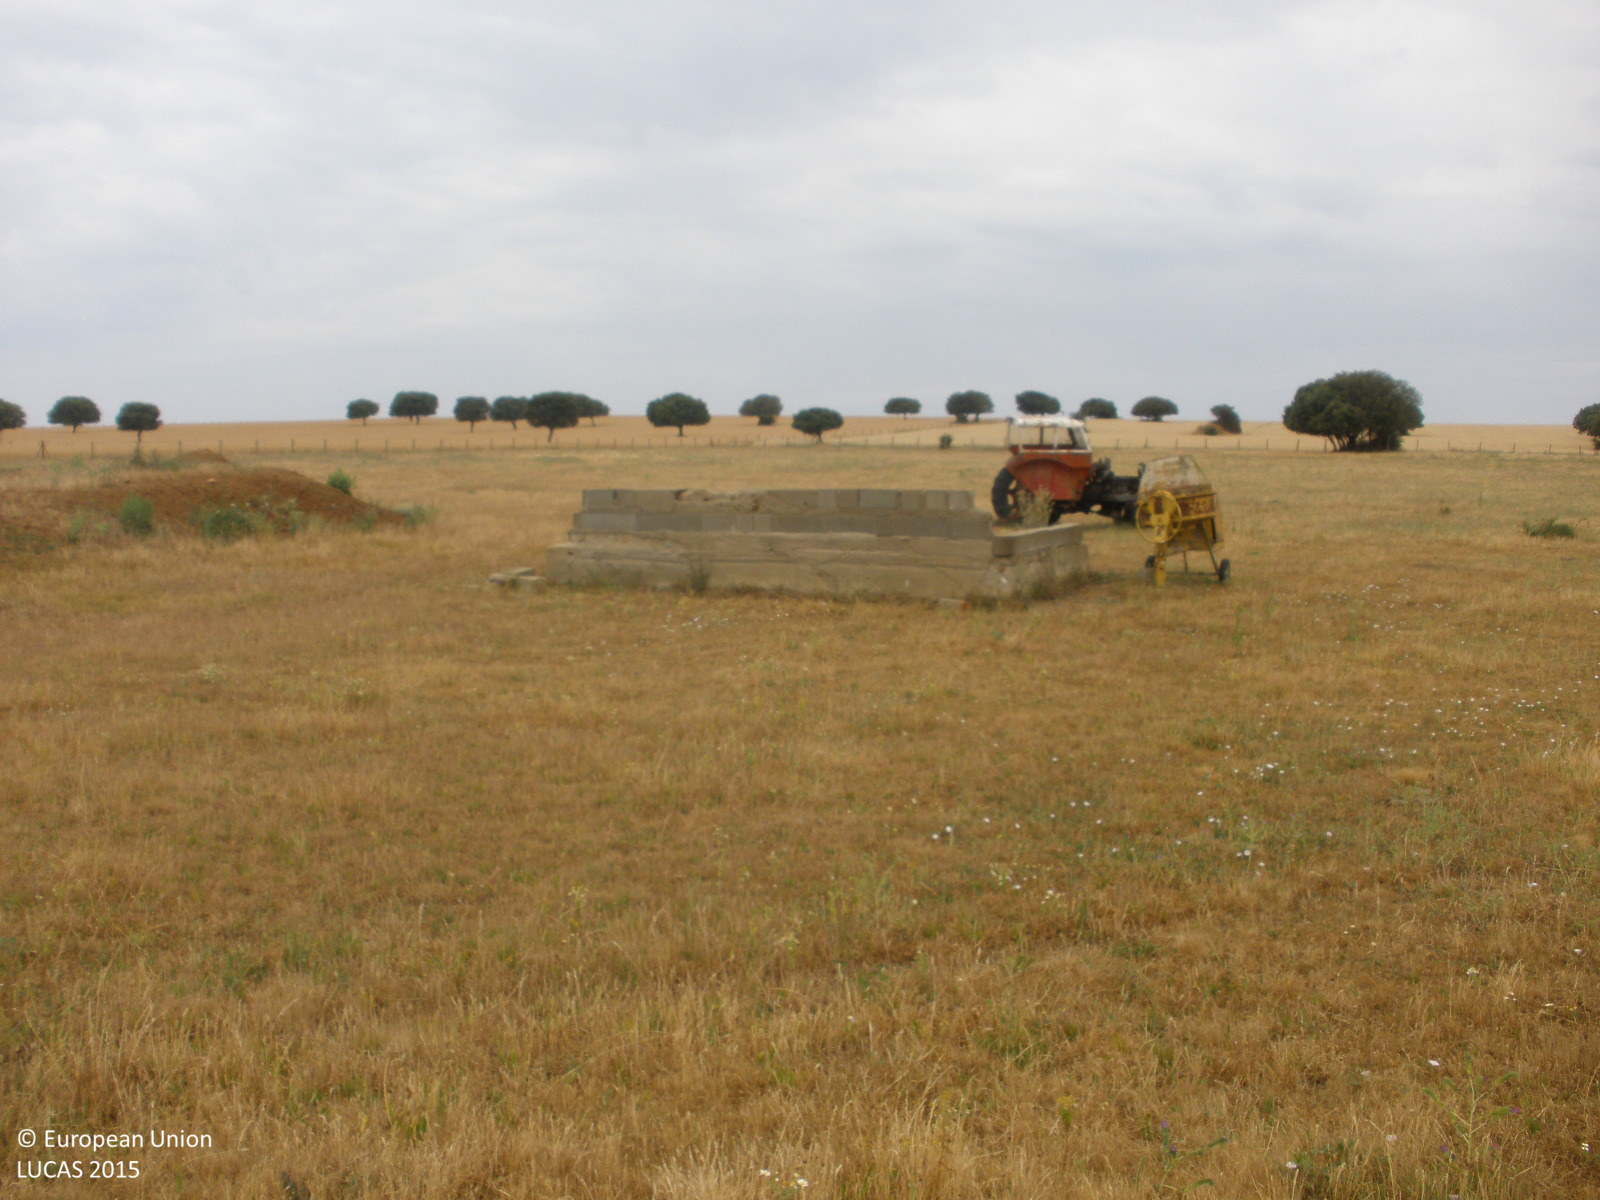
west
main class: Grassland
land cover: Grassland without tree/shrub cover
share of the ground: > 75 %
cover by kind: herbaceous plants 100 %
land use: Agriculture (excluding fallow land and kitchen gardens)
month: June
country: ES
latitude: 40.6777
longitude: -6.0890
